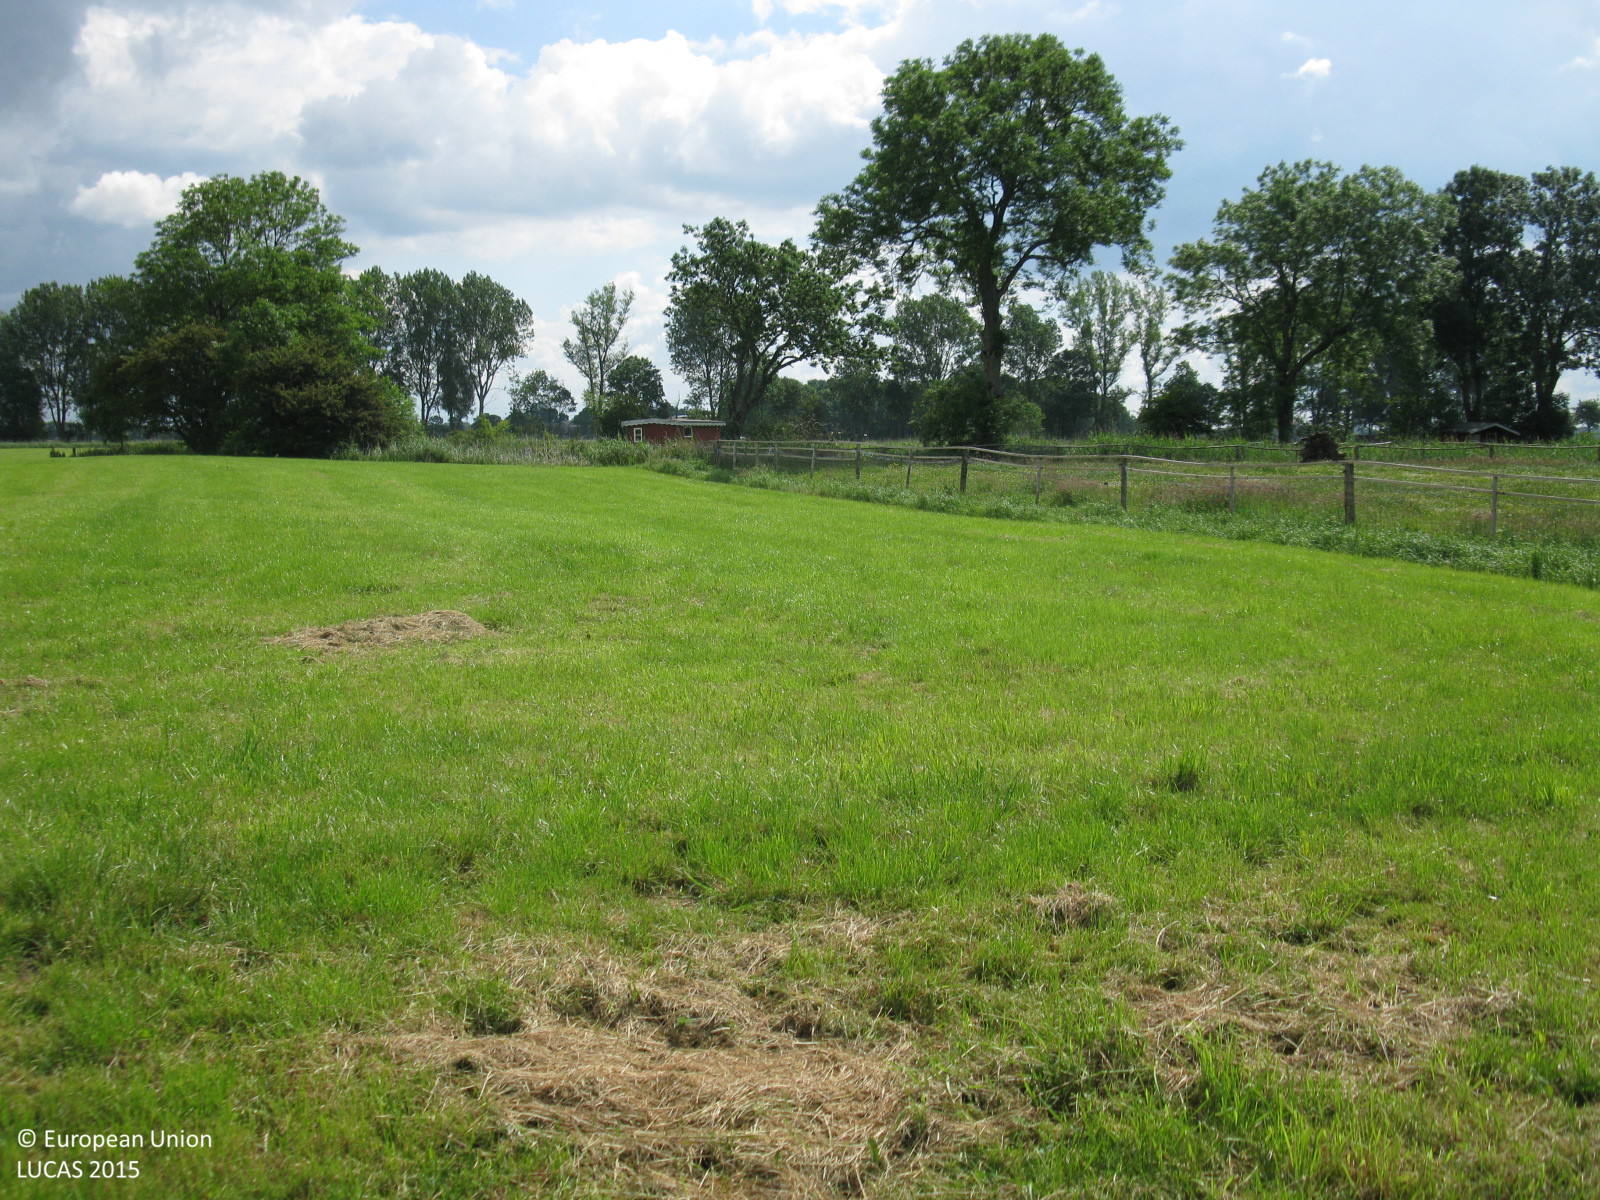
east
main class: Grassland
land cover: Grassland without tree/shrub cover
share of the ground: > 75 %
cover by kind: herbaceous plants 100 %
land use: Agriculture (excluding fallow land and kitchen gardens)
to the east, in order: Grassland without tree/shrub cover; Fences; Grass margins; Ditches and canals; Artificial constructions in urban areas; Broadleaved woodland; Ditches and canals; Fences; Grassland without tree/shrub cover
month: June
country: DE
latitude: 53.5107
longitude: 7.9650
